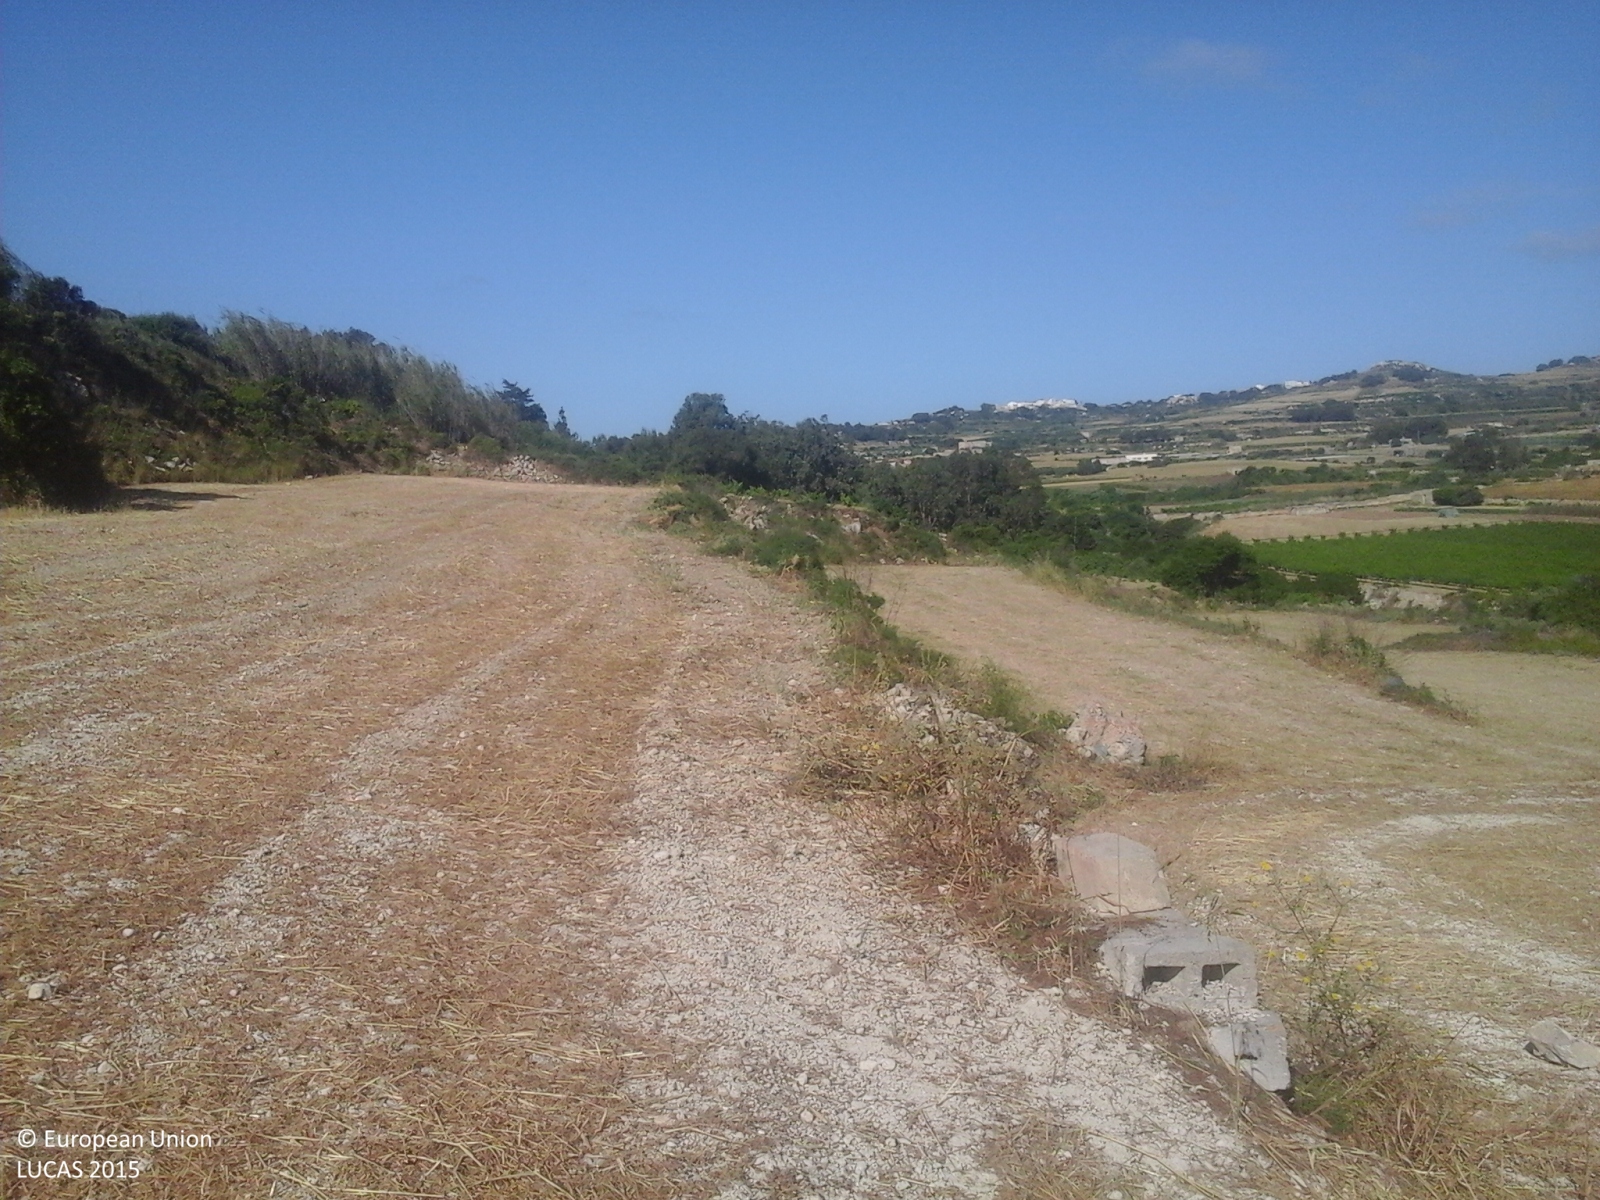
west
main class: Cropland
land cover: Mixed cereals for fodder
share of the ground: > 75 %
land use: Agriculture (excluding fallow land and kitchen gardens)
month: May
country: MT
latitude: 35.8987
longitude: 14.4021
